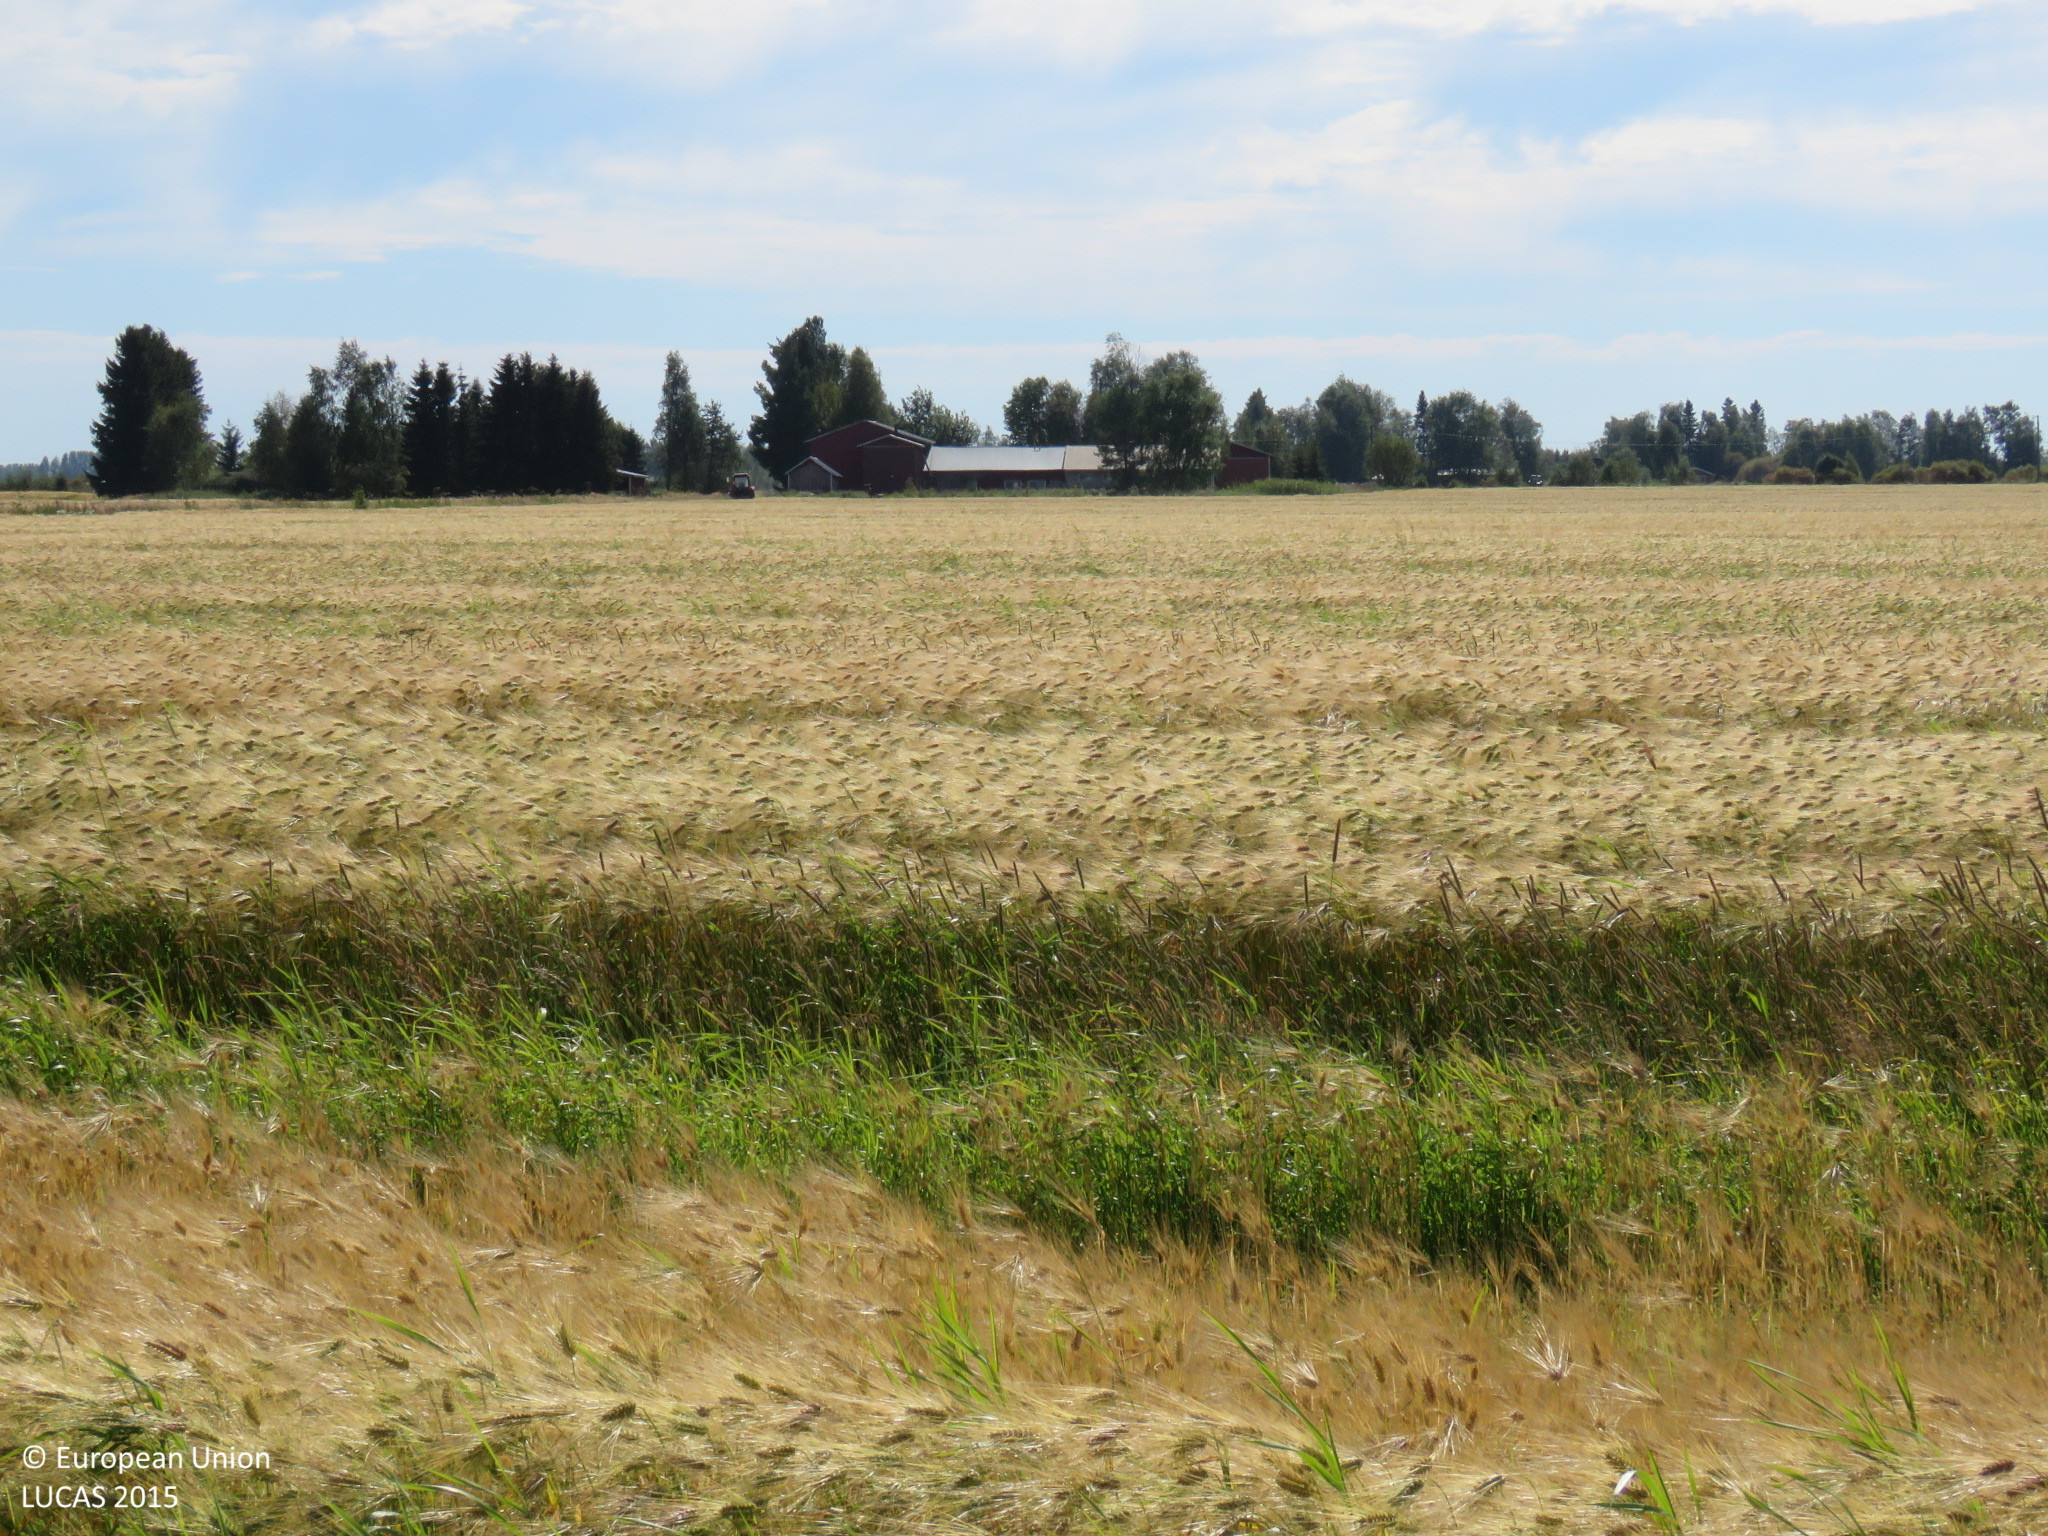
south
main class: Cropland
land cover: Barley
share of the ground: > 75 %
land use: Agriculture (excluding fallow land and kitchen gardens)
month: August
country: FI
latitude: 64.8421
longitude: 25.5832
